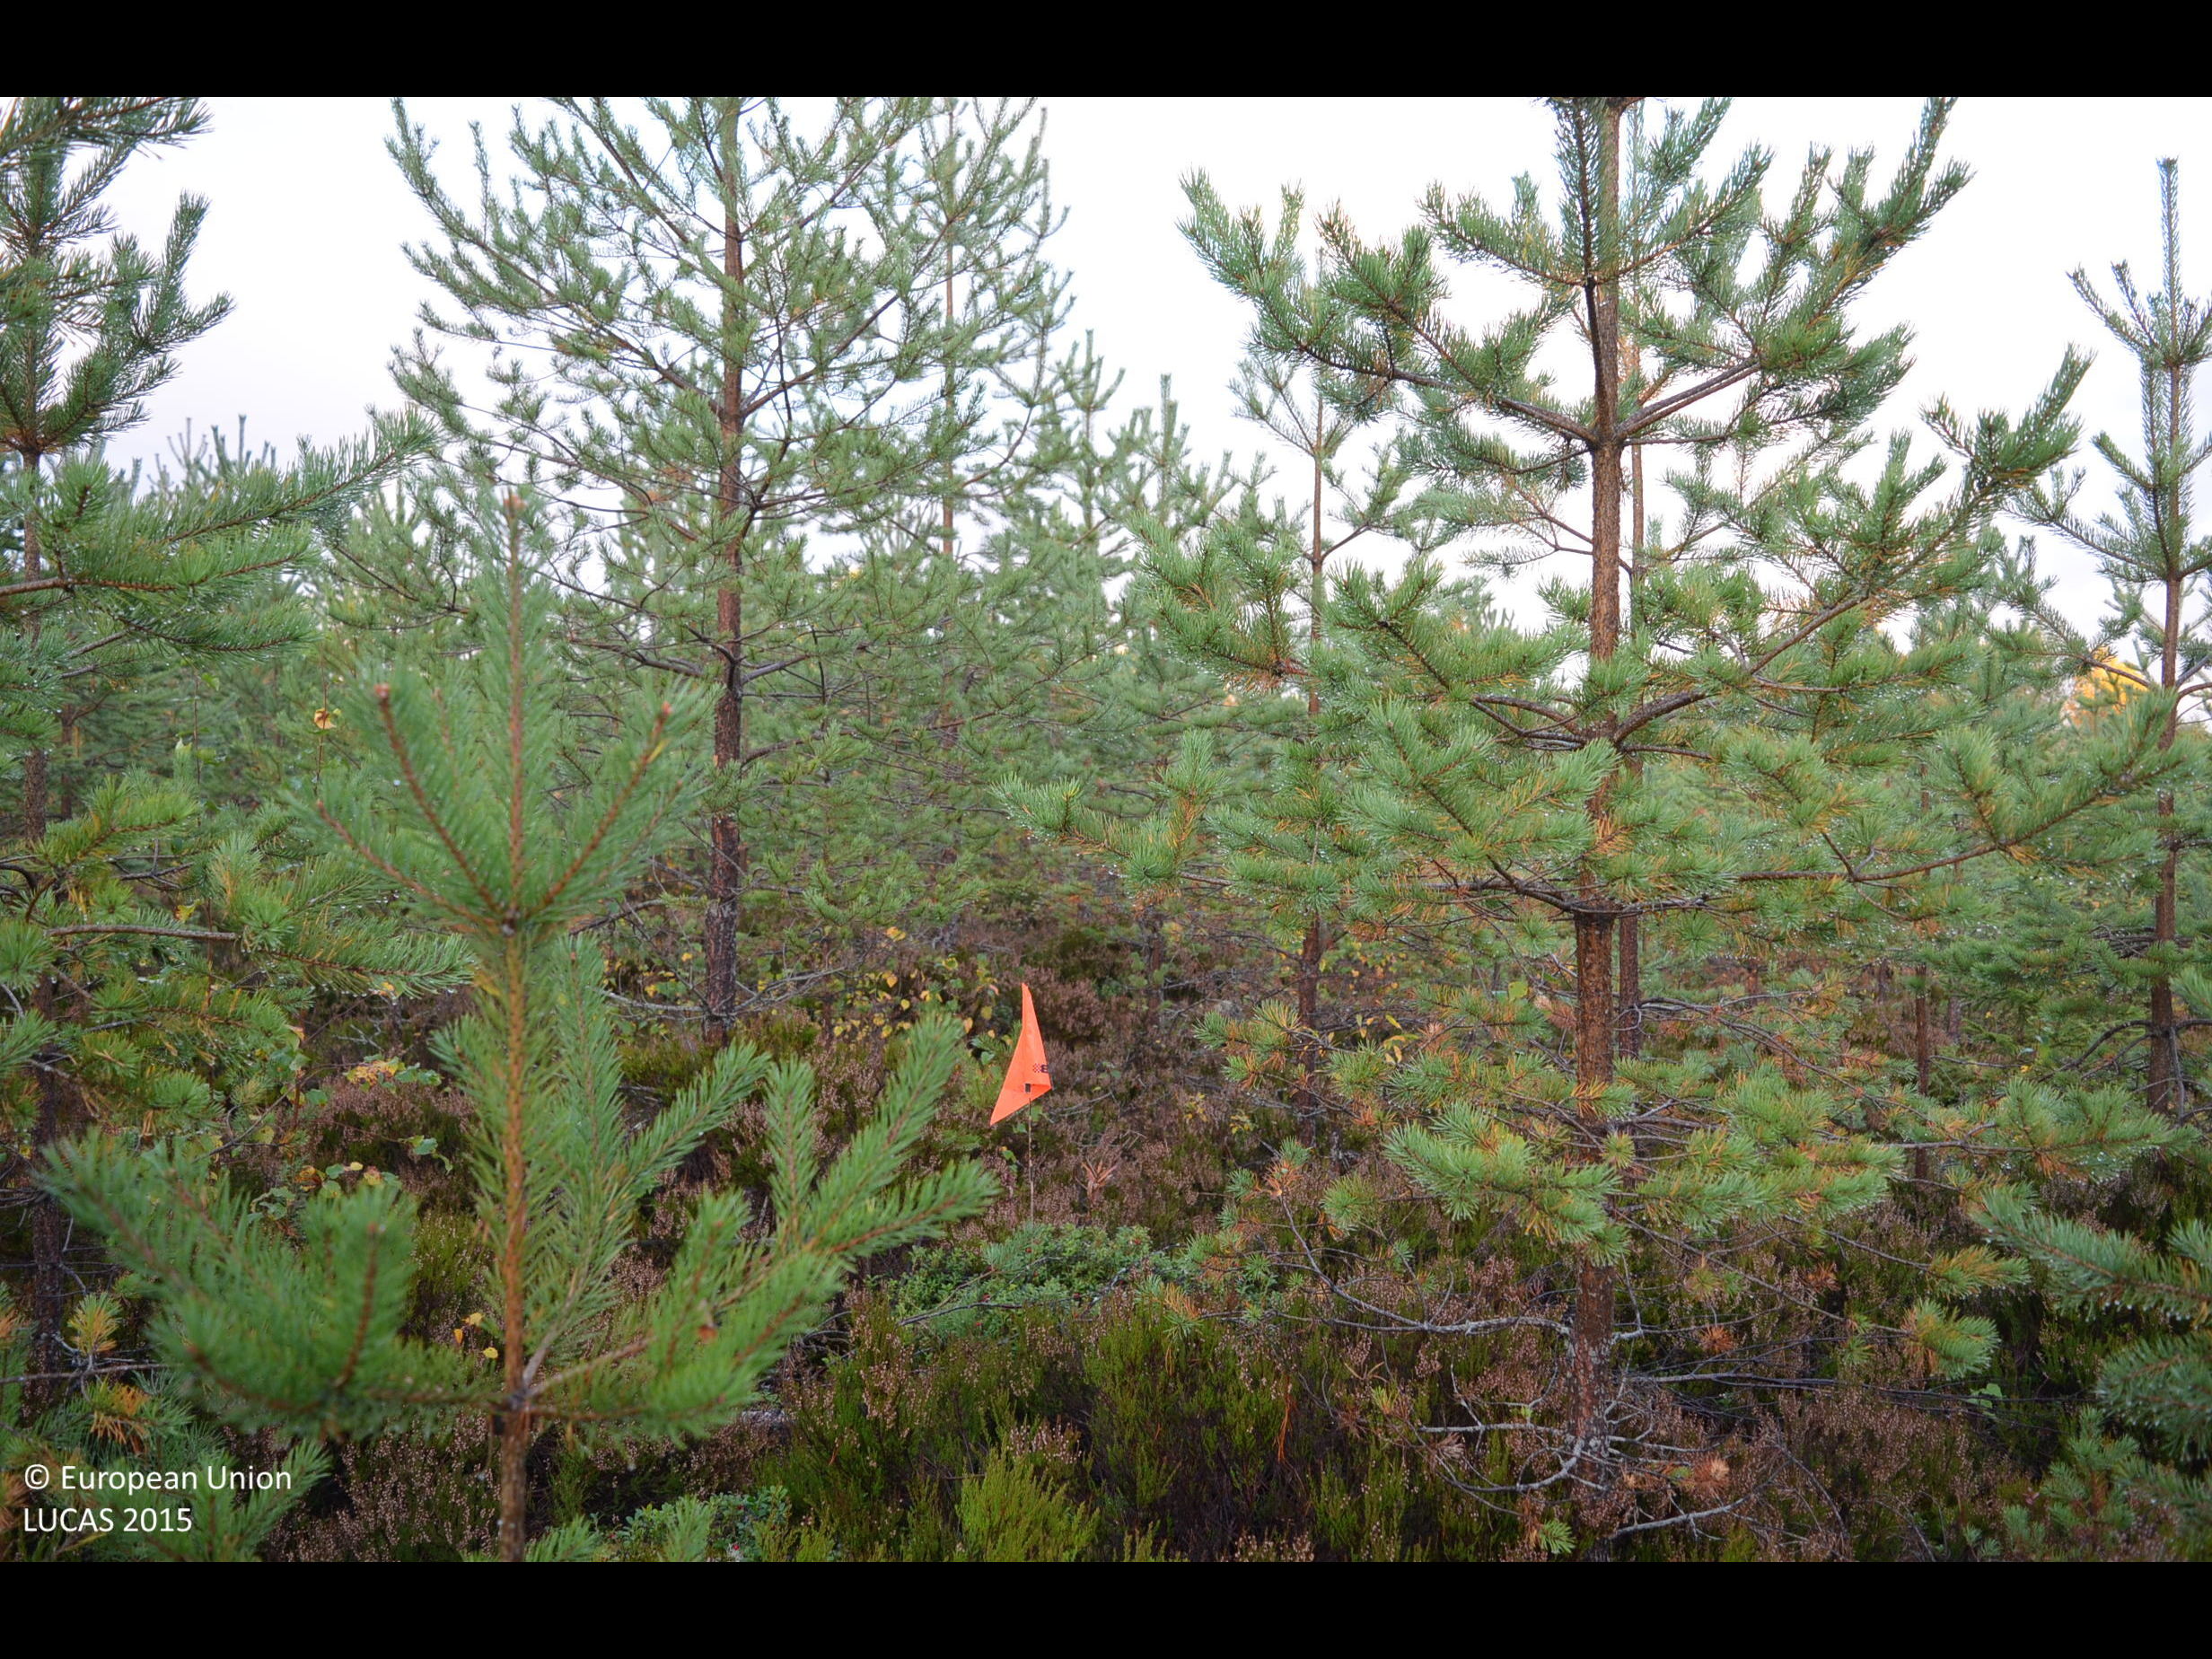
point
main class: Woodland
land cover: Pine dominated coniferous woodland
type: boreal forest
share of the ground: > 75 %
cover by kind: coniferous forest trees 75 %, shrubs 25 %
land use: Forestry
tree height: < 5 m
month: September
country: FI
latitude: 62.7480
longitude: 23.7564
